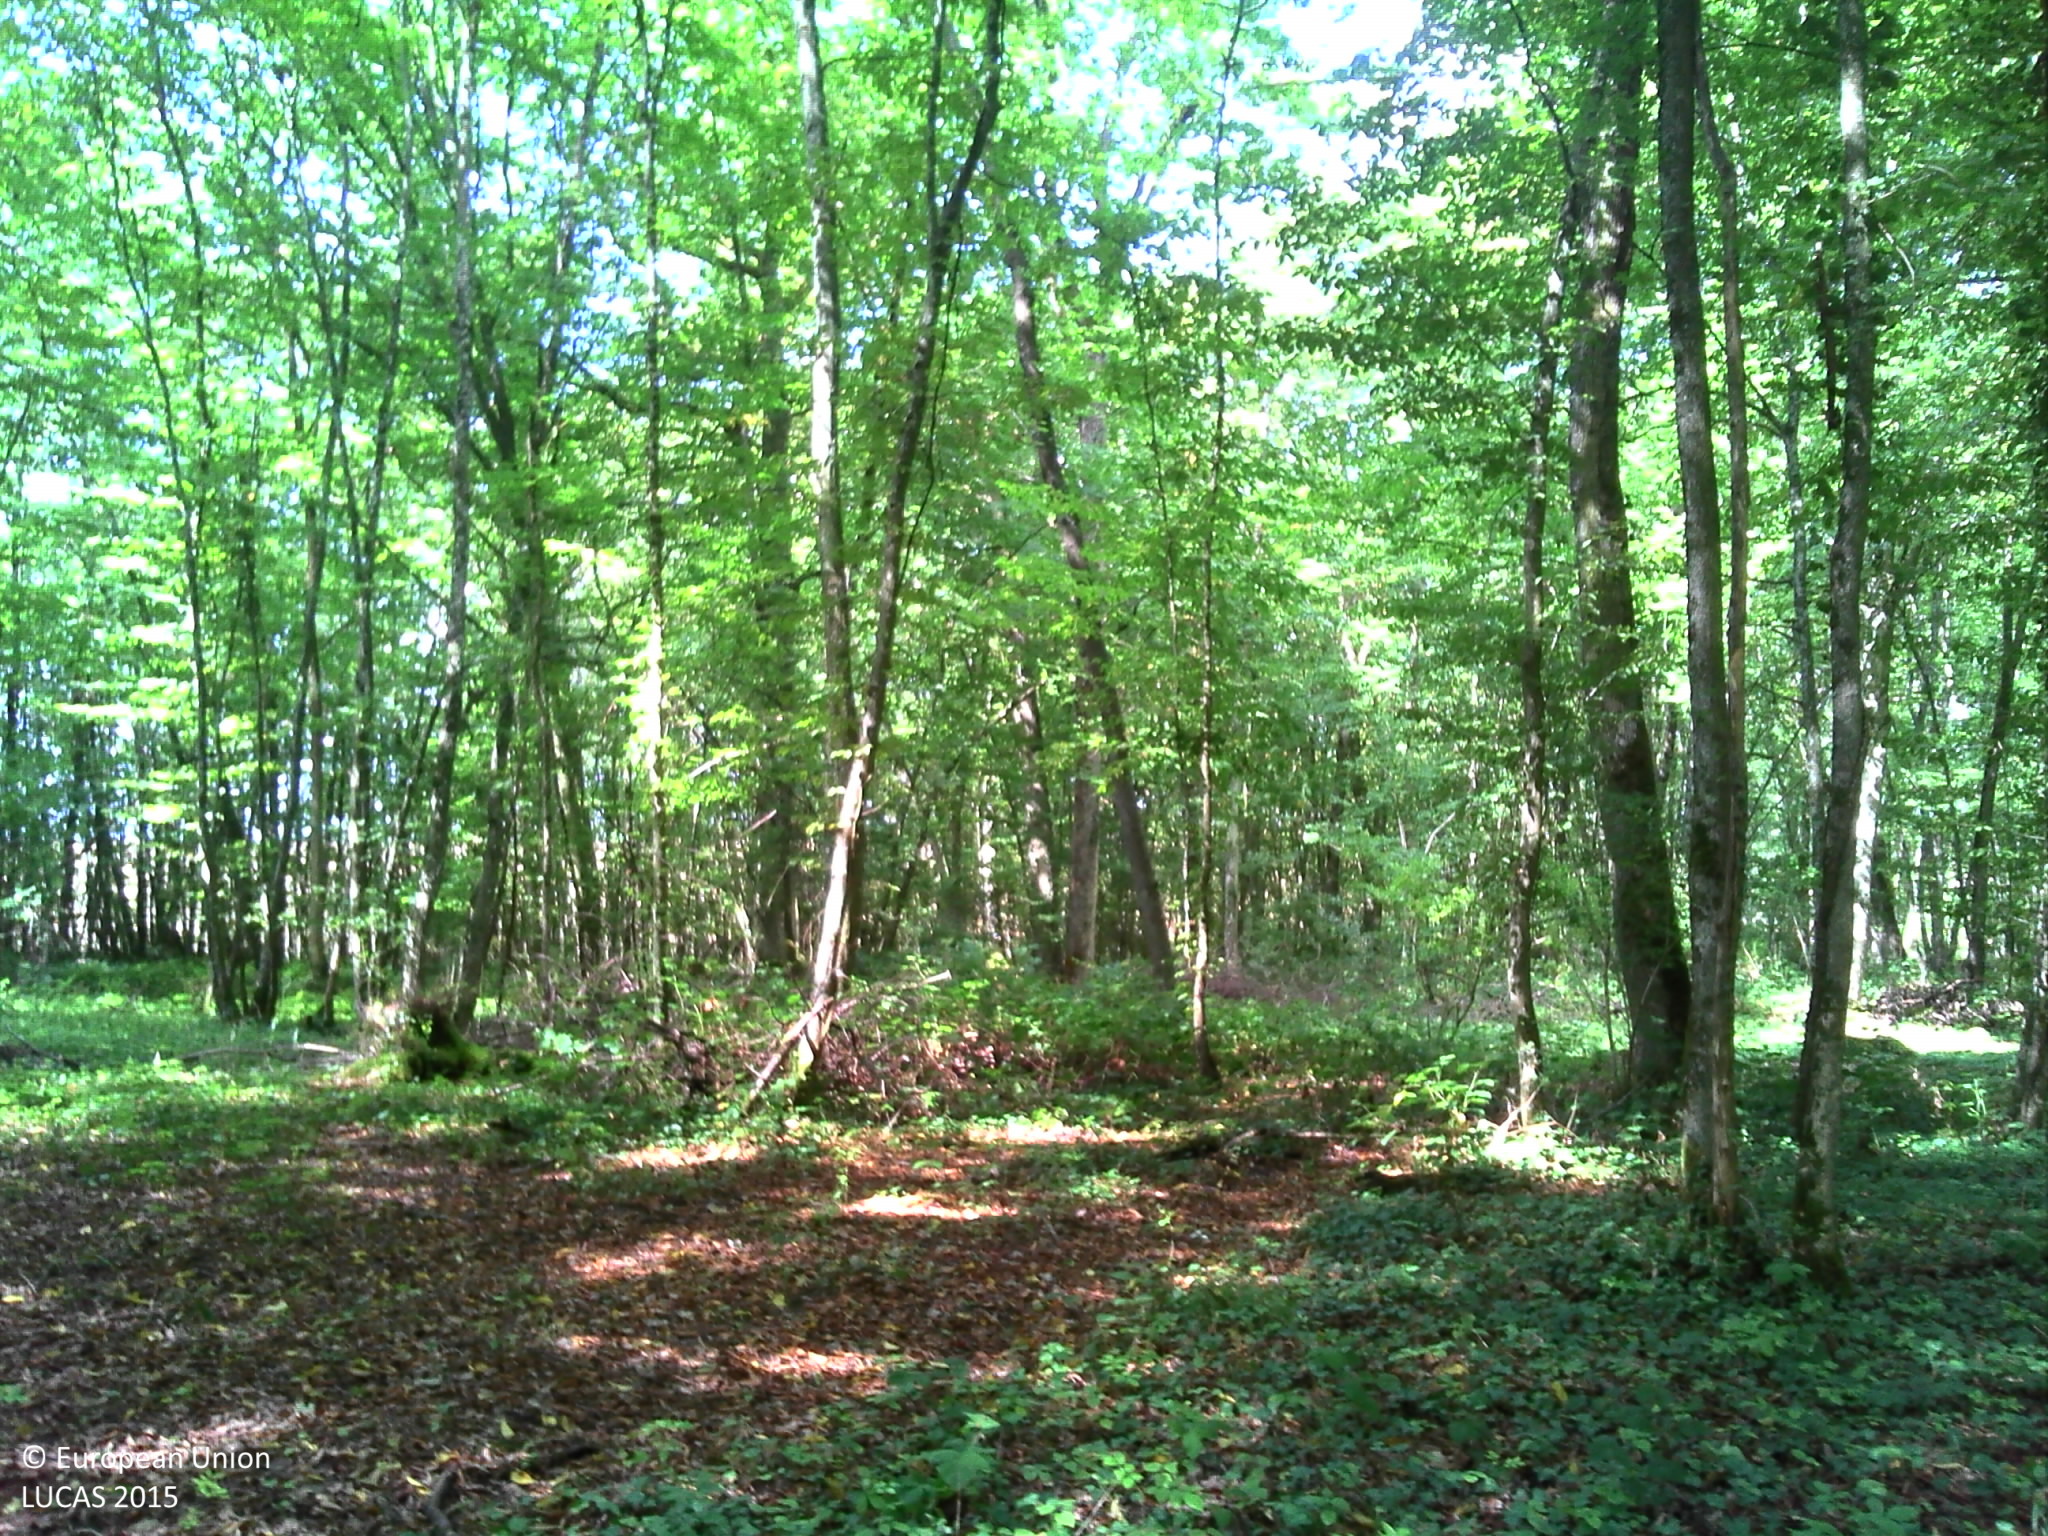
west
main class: Woodland
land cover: Broadleaved woodland
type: mesophytic deciduous forest
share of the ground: > 75 %
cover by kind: broadleaved forest trees 85 %, herbaceous plants 10 %, consolidated bare surface 5 %
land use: Forestry
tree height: > 5 m
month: September
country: FR
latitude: 48.7819
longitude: 6.0122
